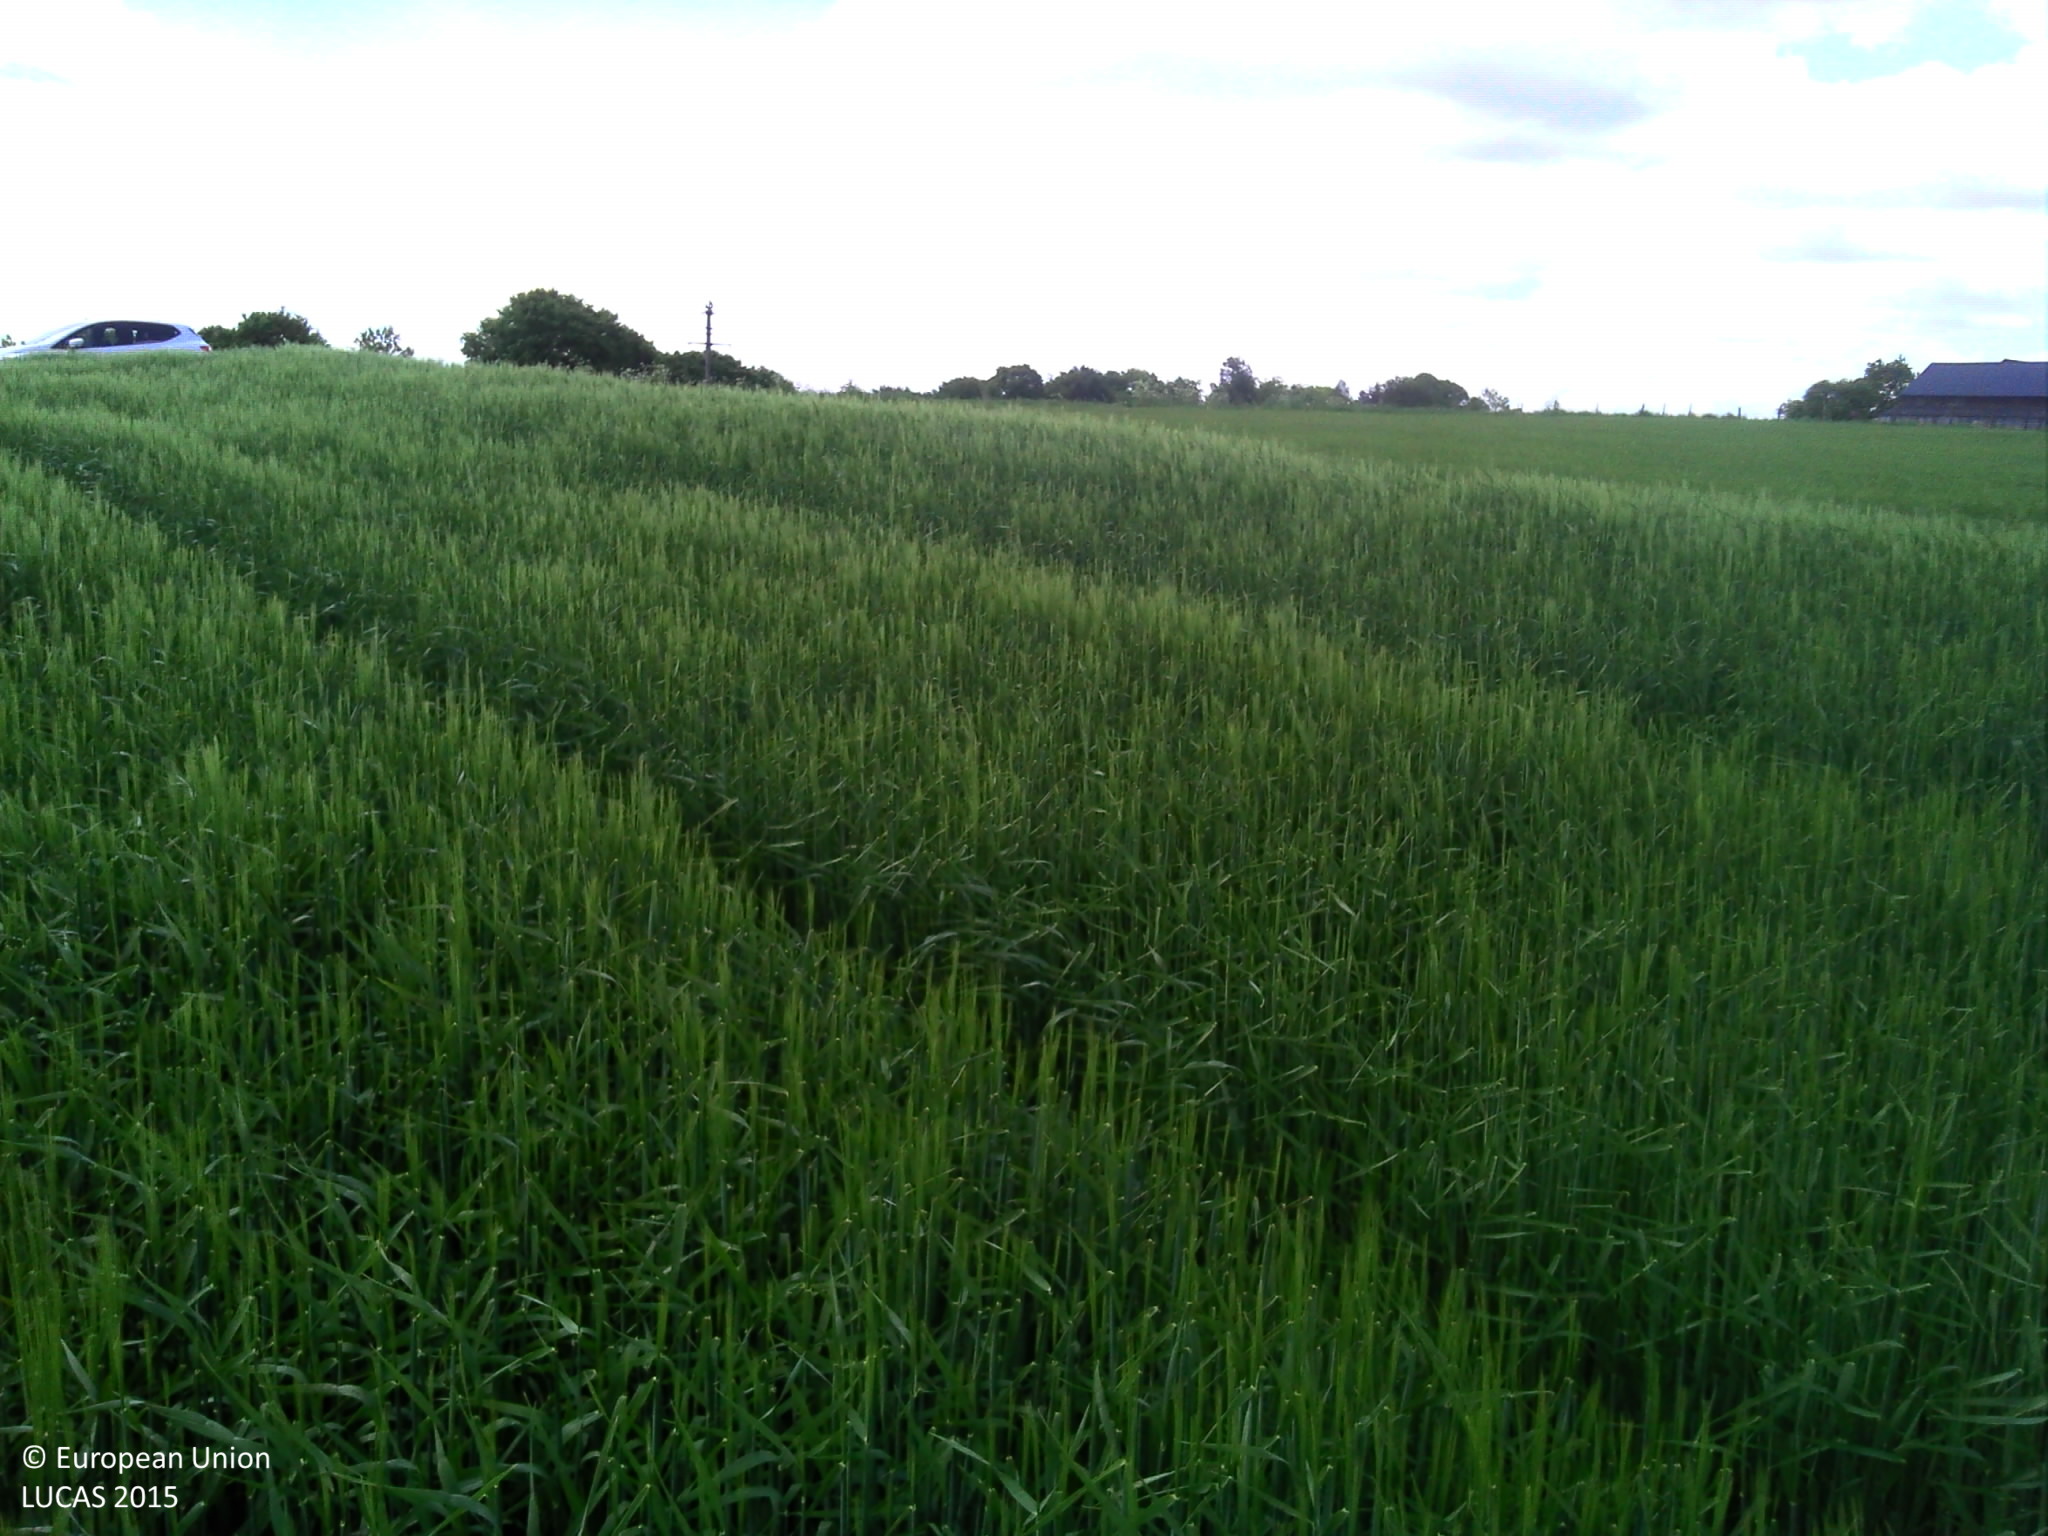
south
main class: Cropland
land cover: Barley
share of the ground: > 75 %
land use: Agriculture (excluding fallow land and kitchen gardens)
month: May
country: LU
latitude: 50.0418
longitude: 5.9916
